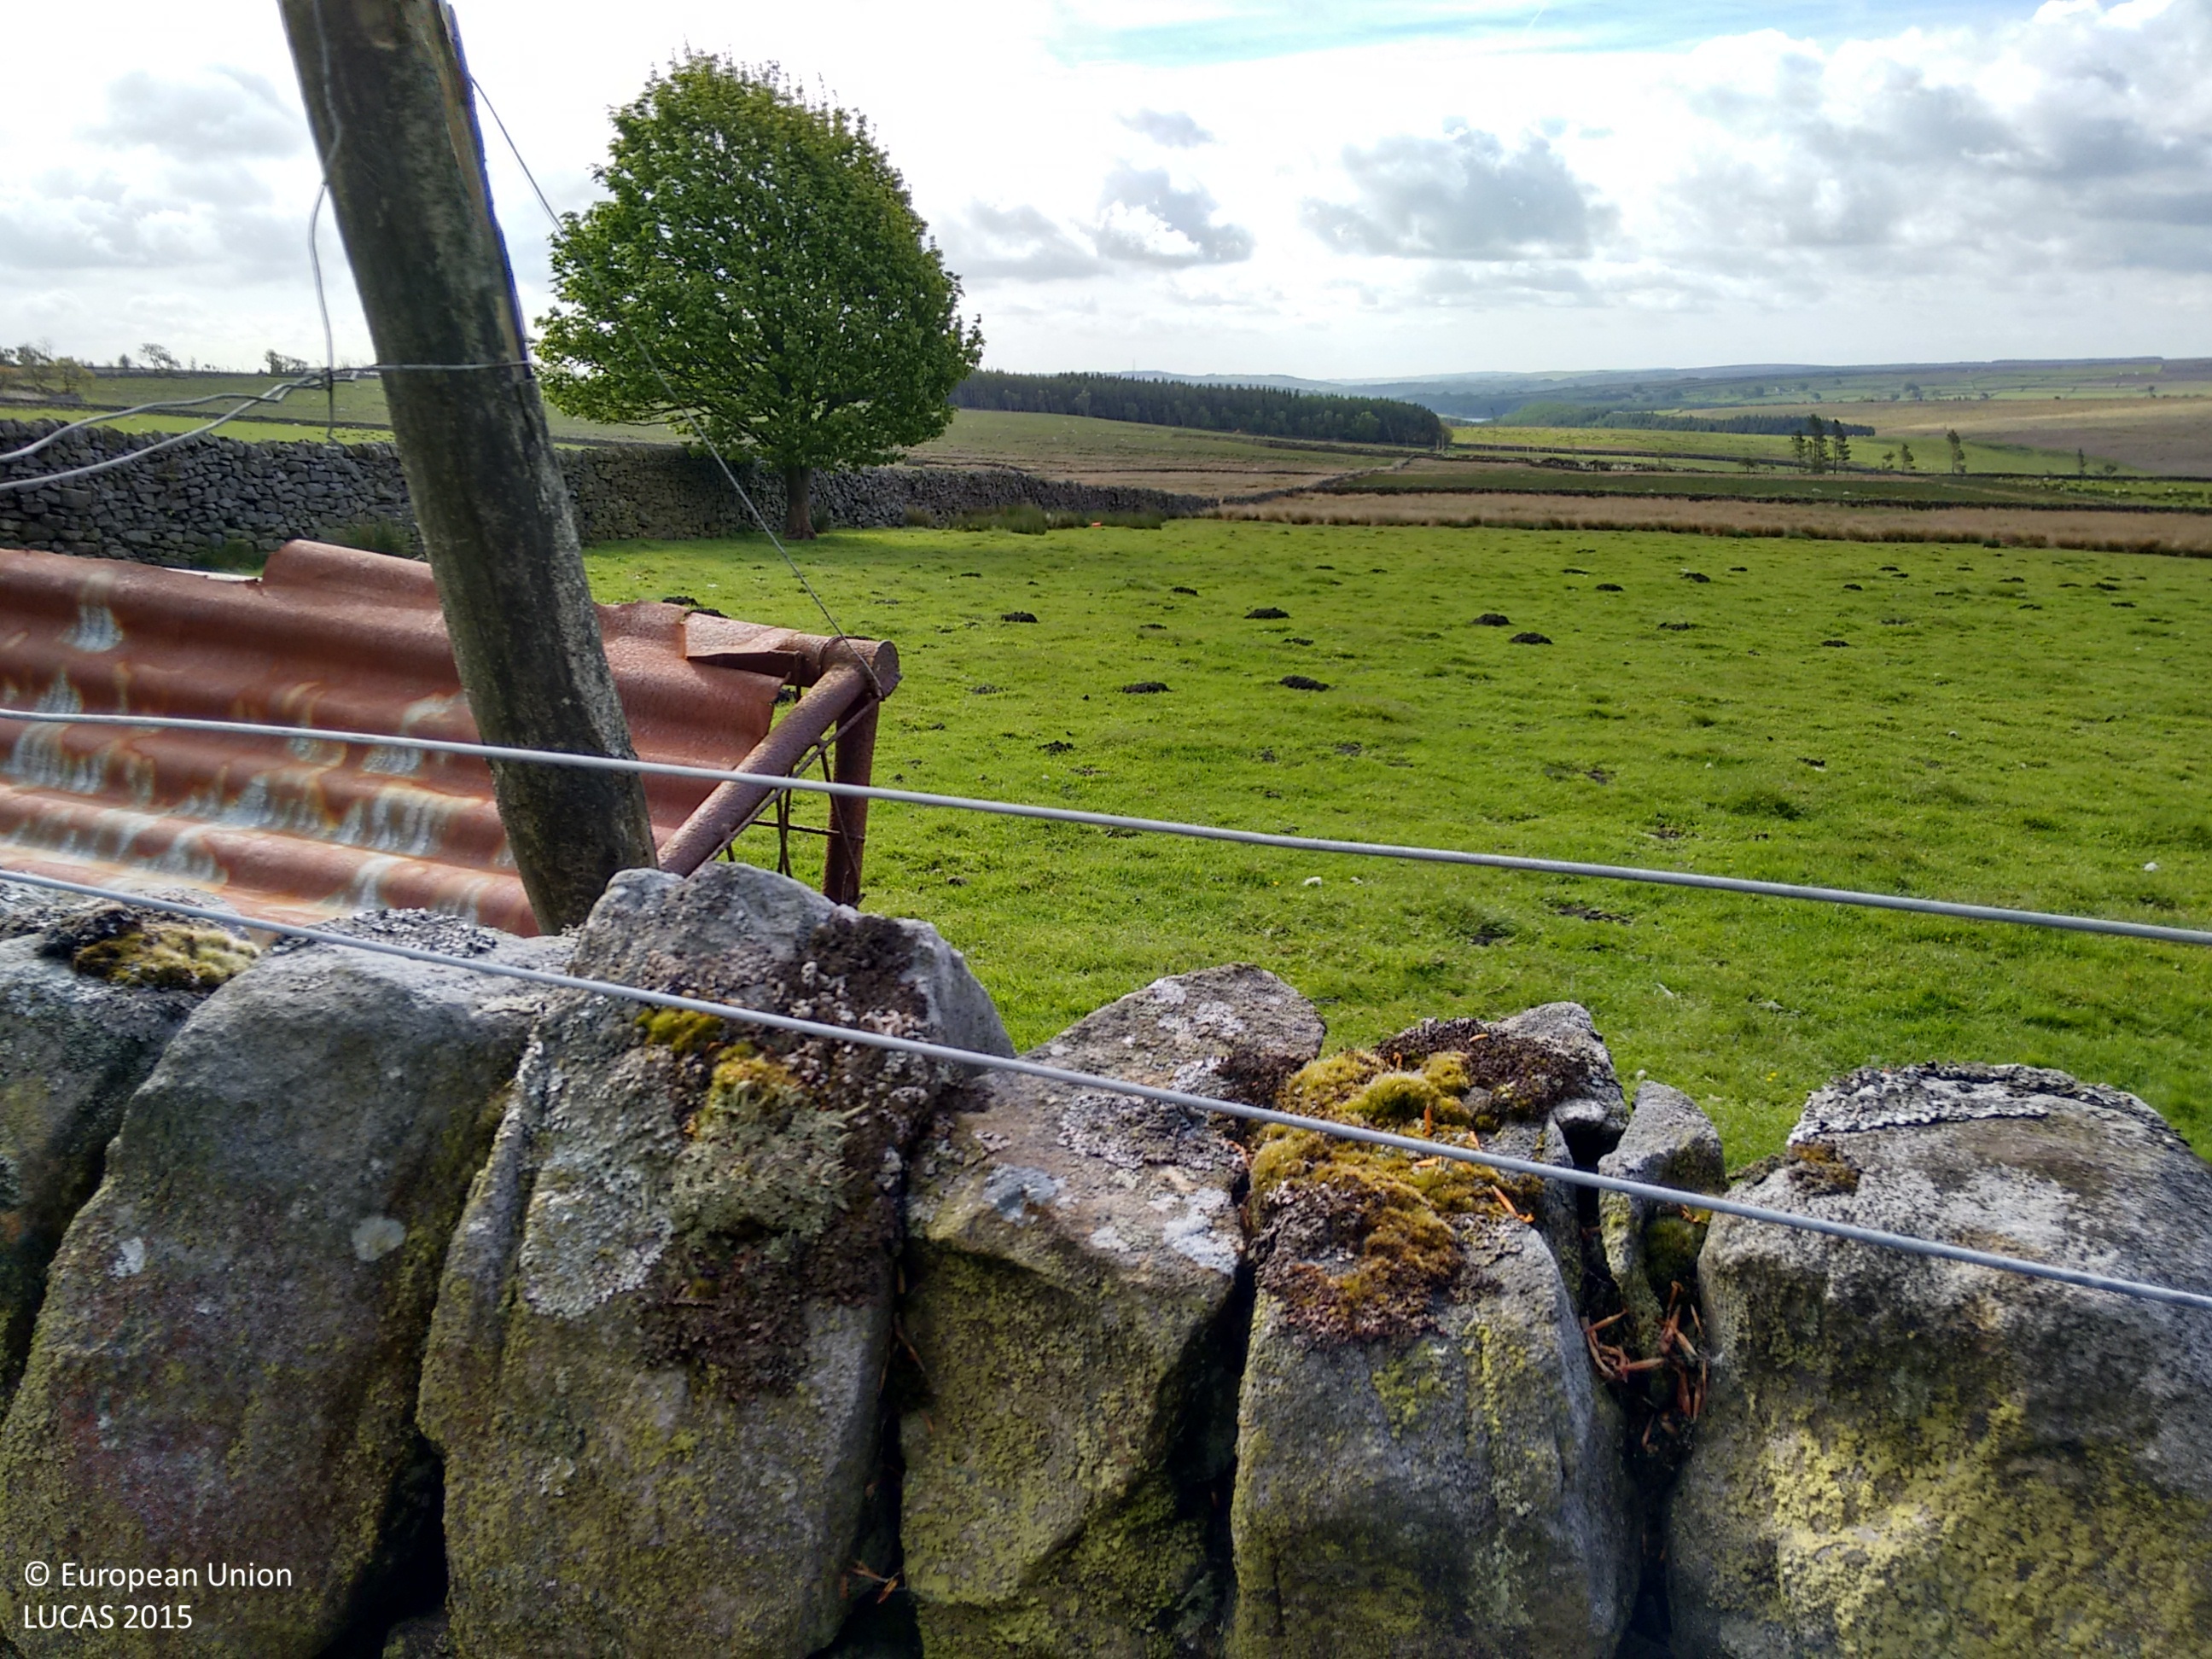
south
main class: Grassland
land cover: Grassland without tree/shrub cover
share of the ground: > 75 %
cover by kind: herbaceous plants 100 %
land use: Agriculture (excluding fallow land and kitchen gardens)
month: June
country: GB
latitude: 54.0410
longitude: -1.7967
